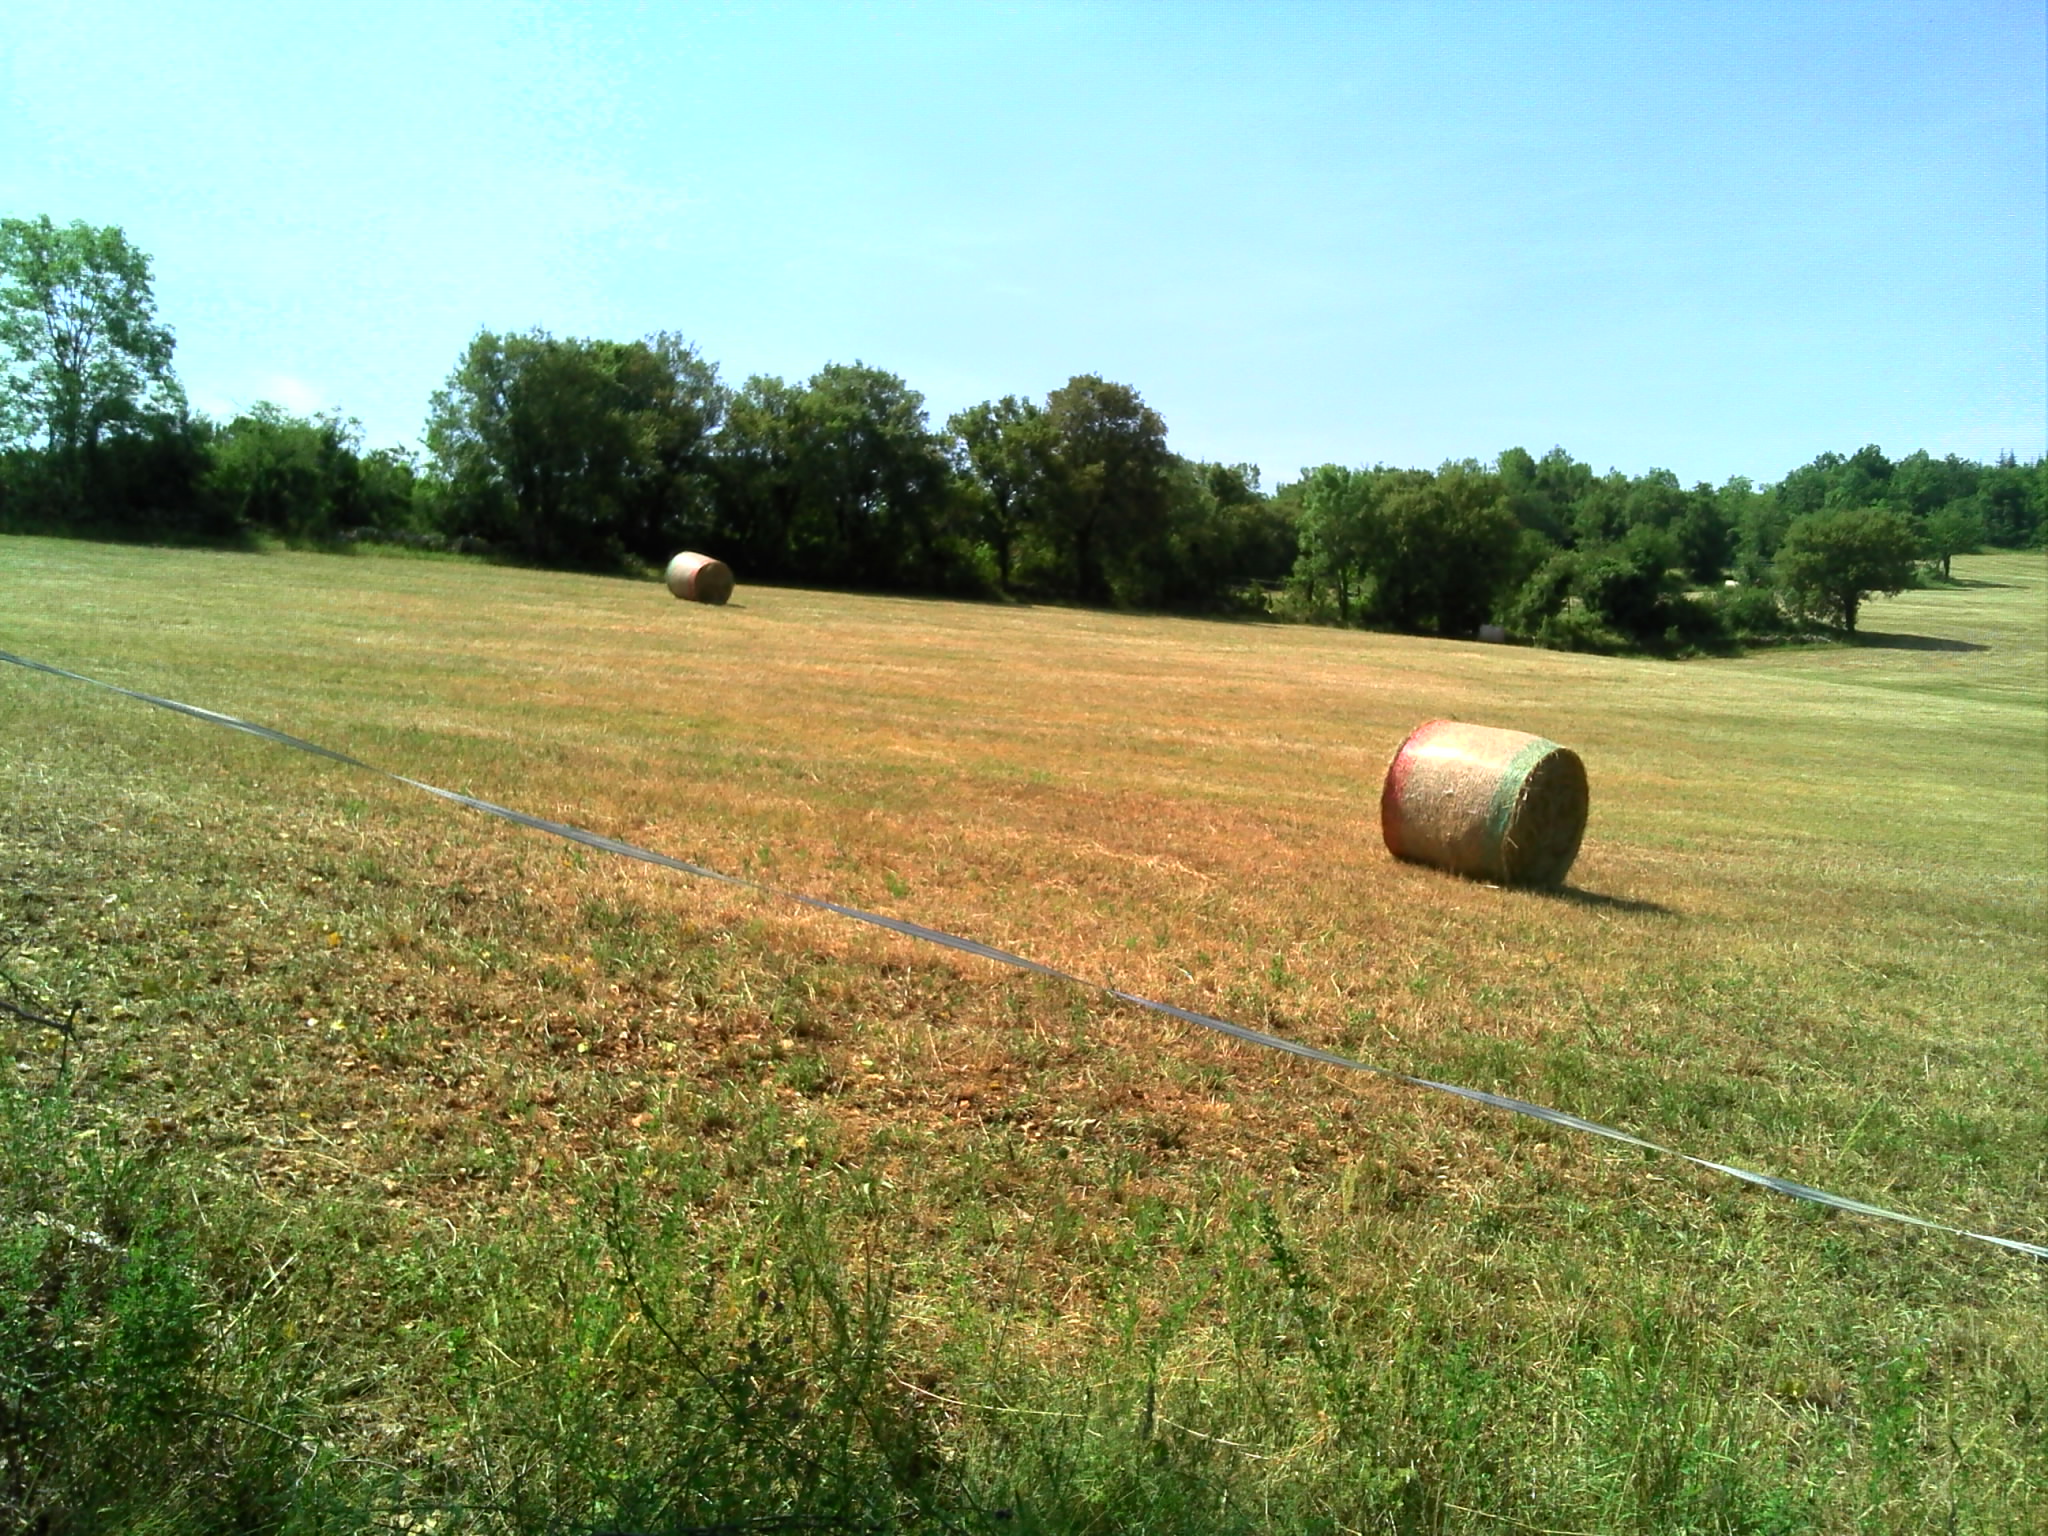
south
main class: Grassland
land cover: Grassland without tree/shrub cover
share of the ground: > 75 %
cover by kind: herbaceous plants 100 %
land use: Agriculture (excluding fallow land and kitchen gardens)
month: June
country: FR
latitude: 44.4977
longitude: 1.8124
